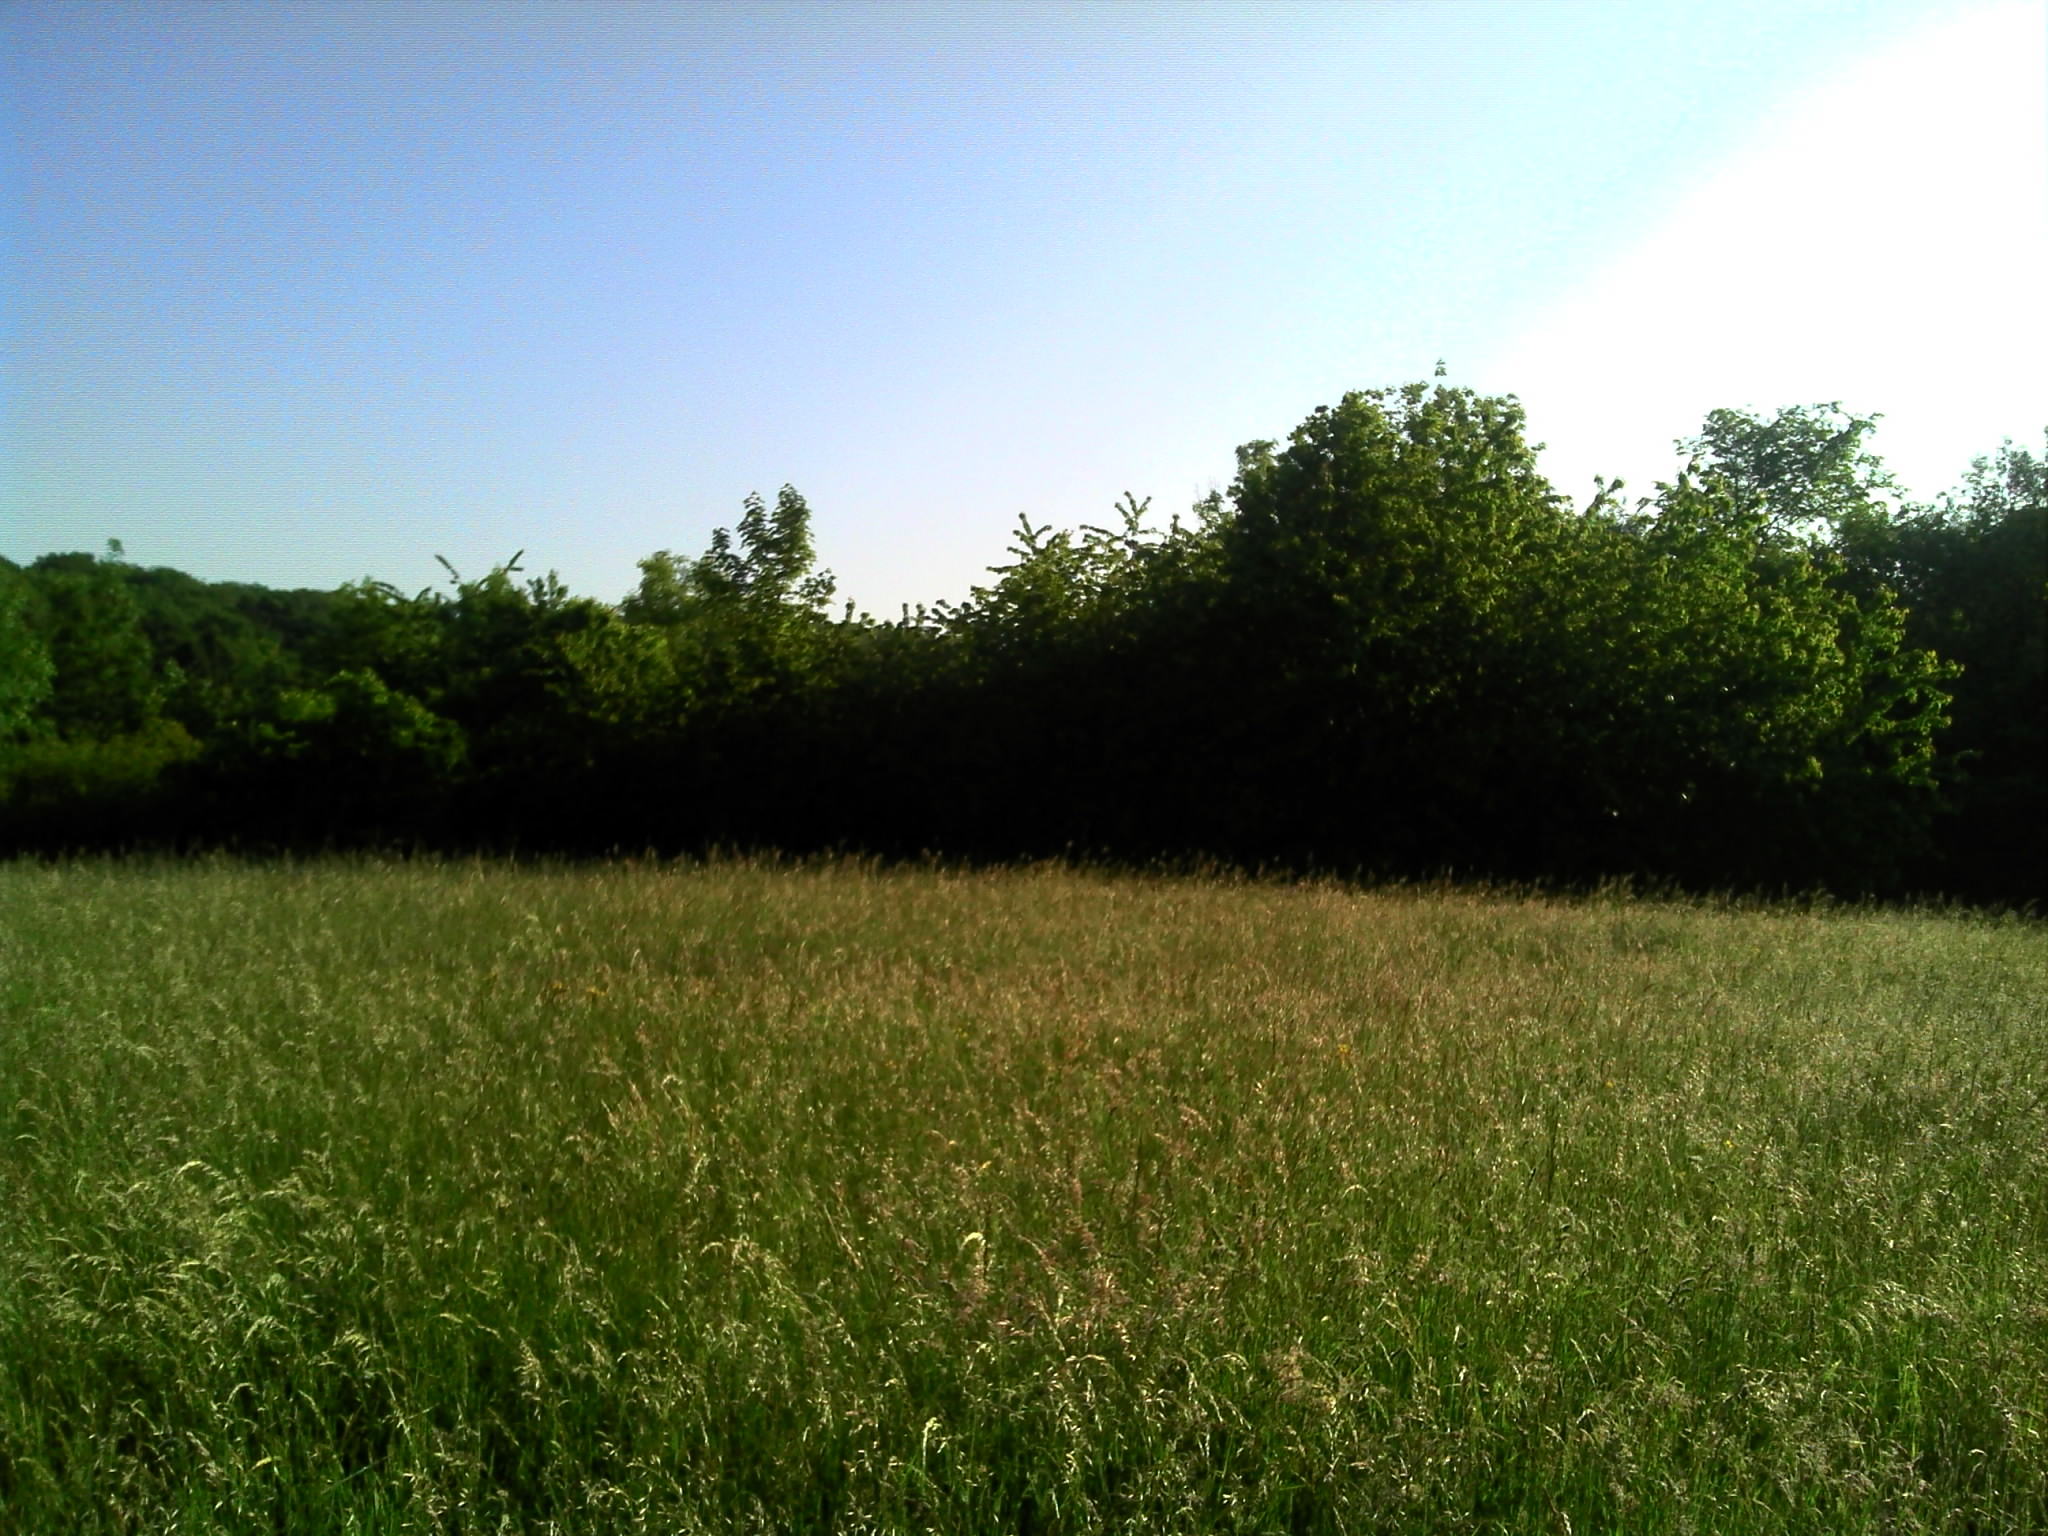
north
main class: Grassland
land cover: Grassland with sparse tree/shrub cover
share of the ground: > 75 %
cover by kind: herbaceous plants 95 %, broadleaved forest trees 5 %
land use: Agriculture (excluding fallow land and kitchen gardens)
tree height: < 5 m
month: May
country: LU
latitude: 49.5502
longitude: 6.3645
